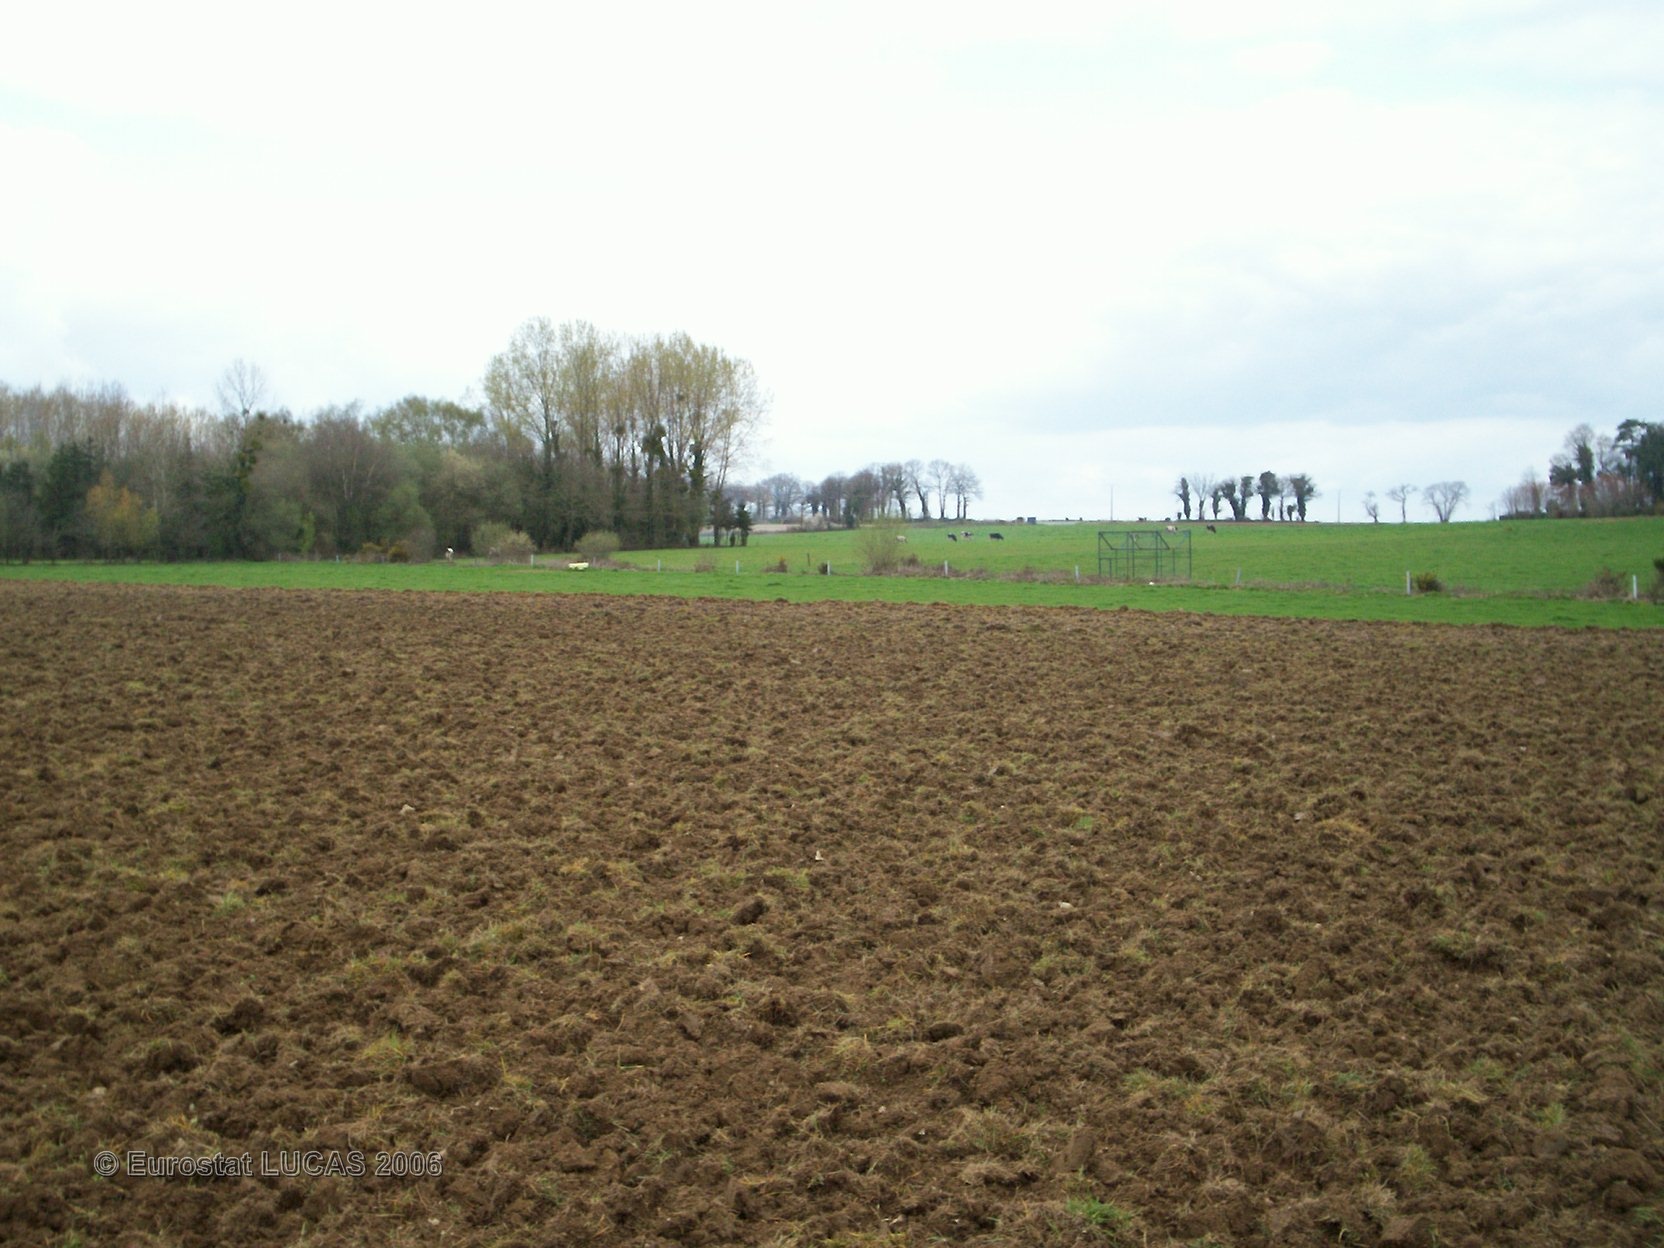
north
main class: Cropland
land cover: Dry pulses
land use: Agriculture (excluding fallow land and kitchen gardens)
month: May
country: FR
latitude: 48.0943
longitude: -2.9438
